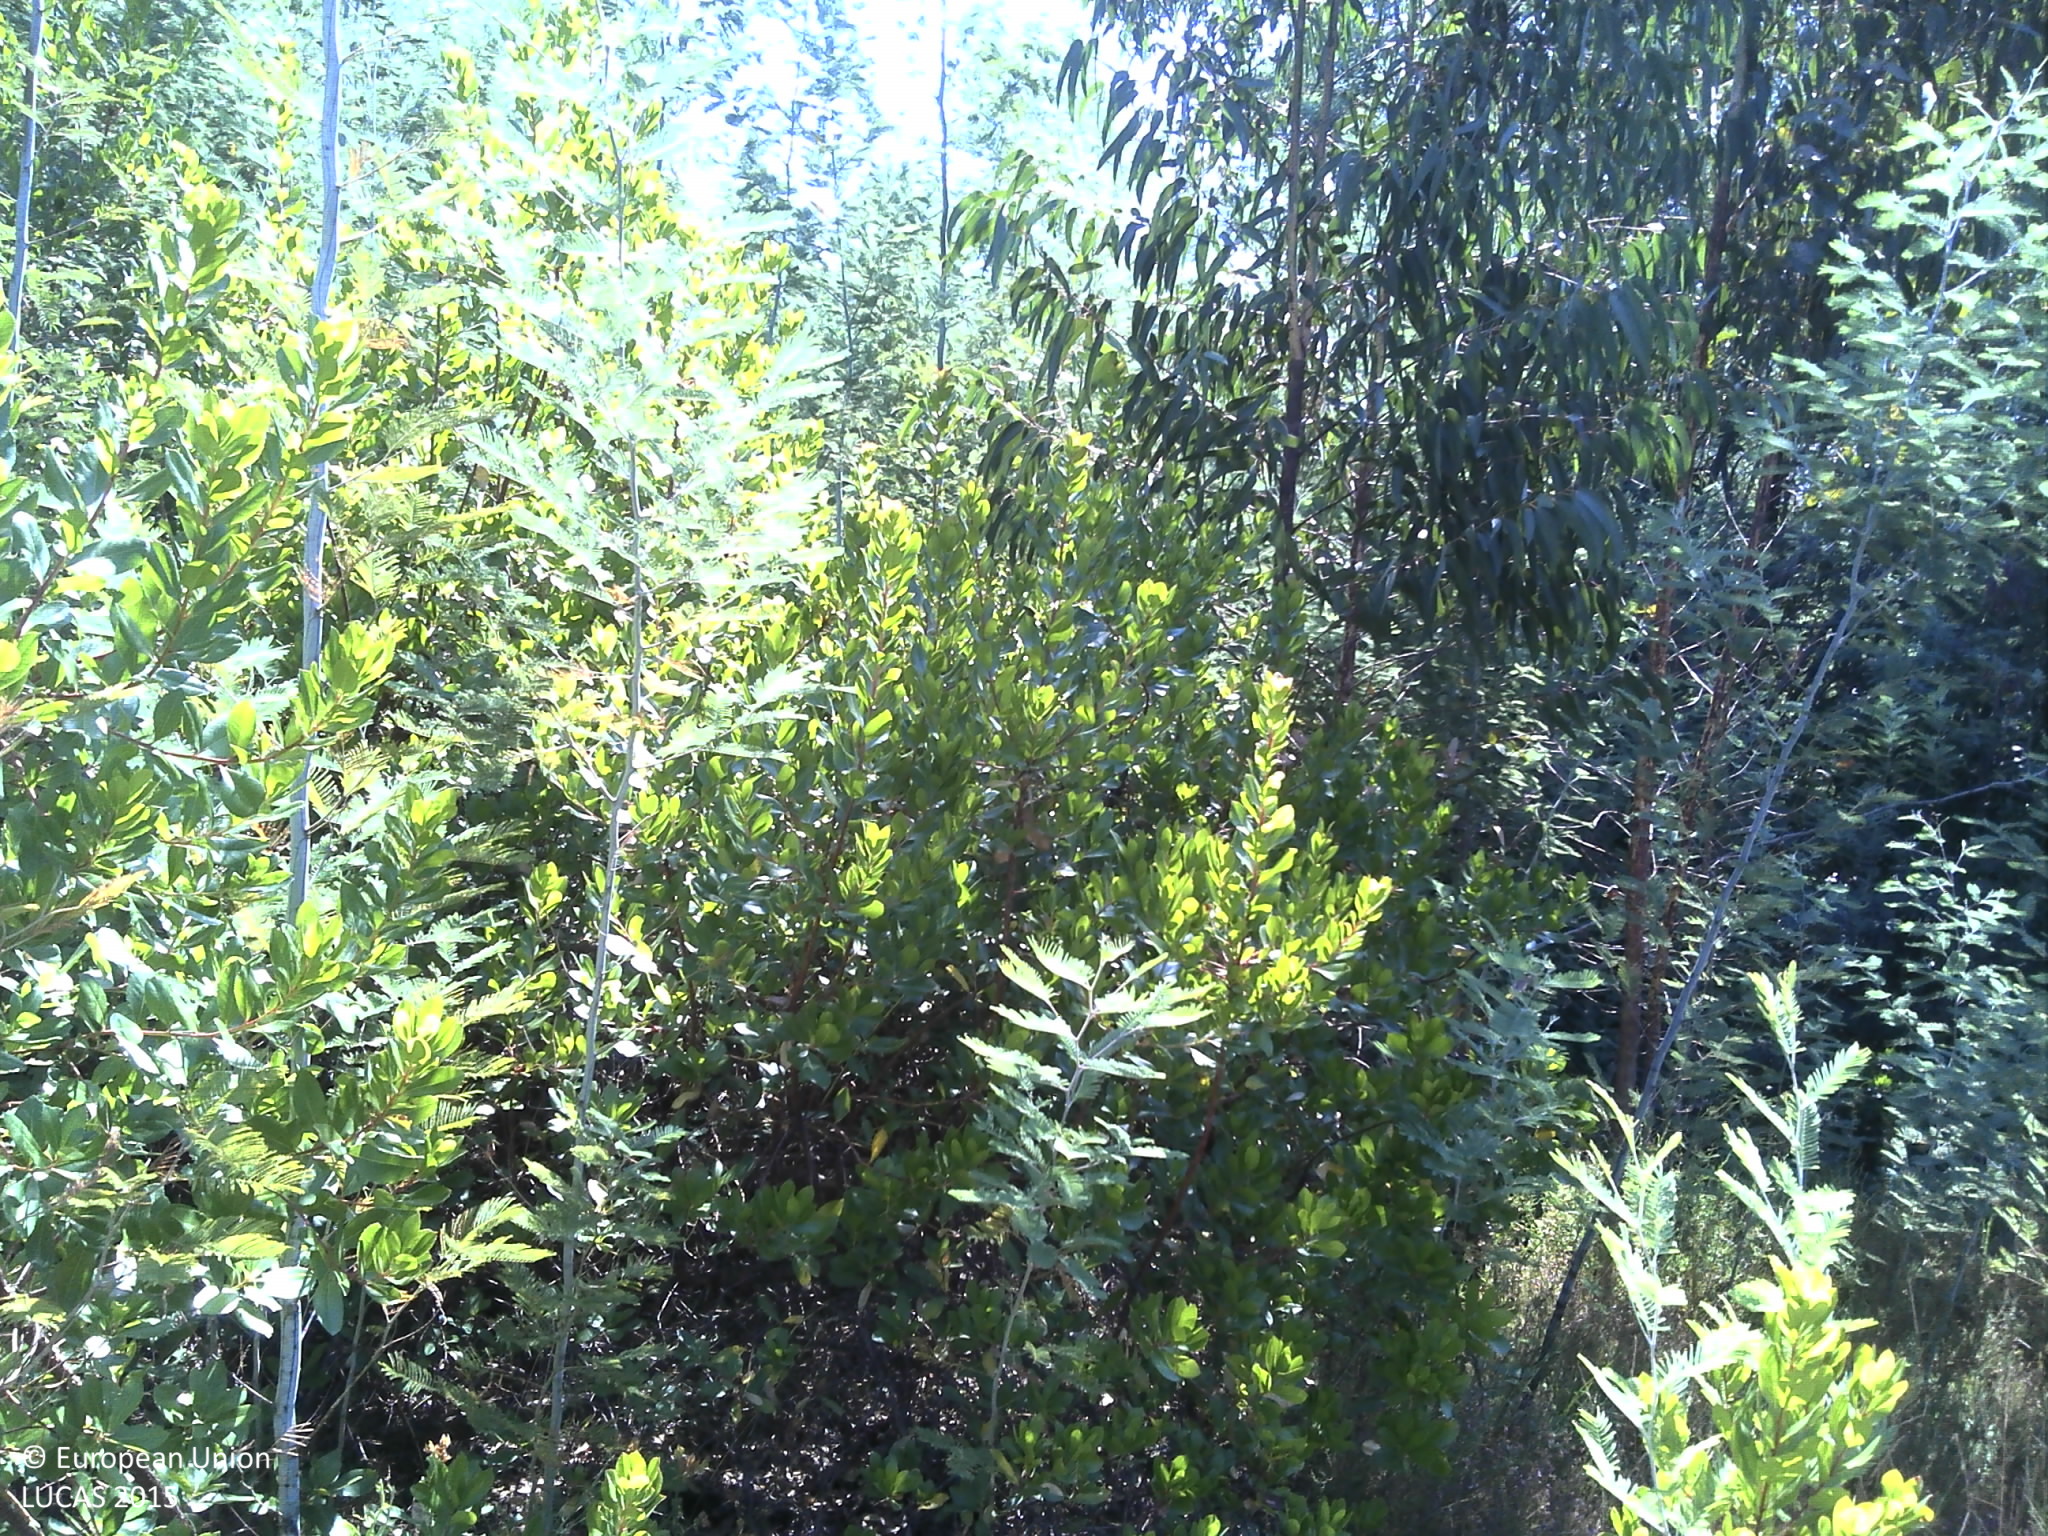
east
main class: Shrubland
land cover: Shrubland with sparse tree cover
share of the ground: > 75 %
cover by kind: shrubs 90 %, broadleaved forest trees 5 %, herbaceous plants 5 %
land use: Semi-natural and natural areas not in use
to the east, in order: Shrubland with sparse tree cover; Broadleaved woodland; Tracks; Pine dominated mixed woodland; Tracks; Pine dominated mixed woodland
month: June
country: PT
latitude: 40.1676
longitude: -8.2426
